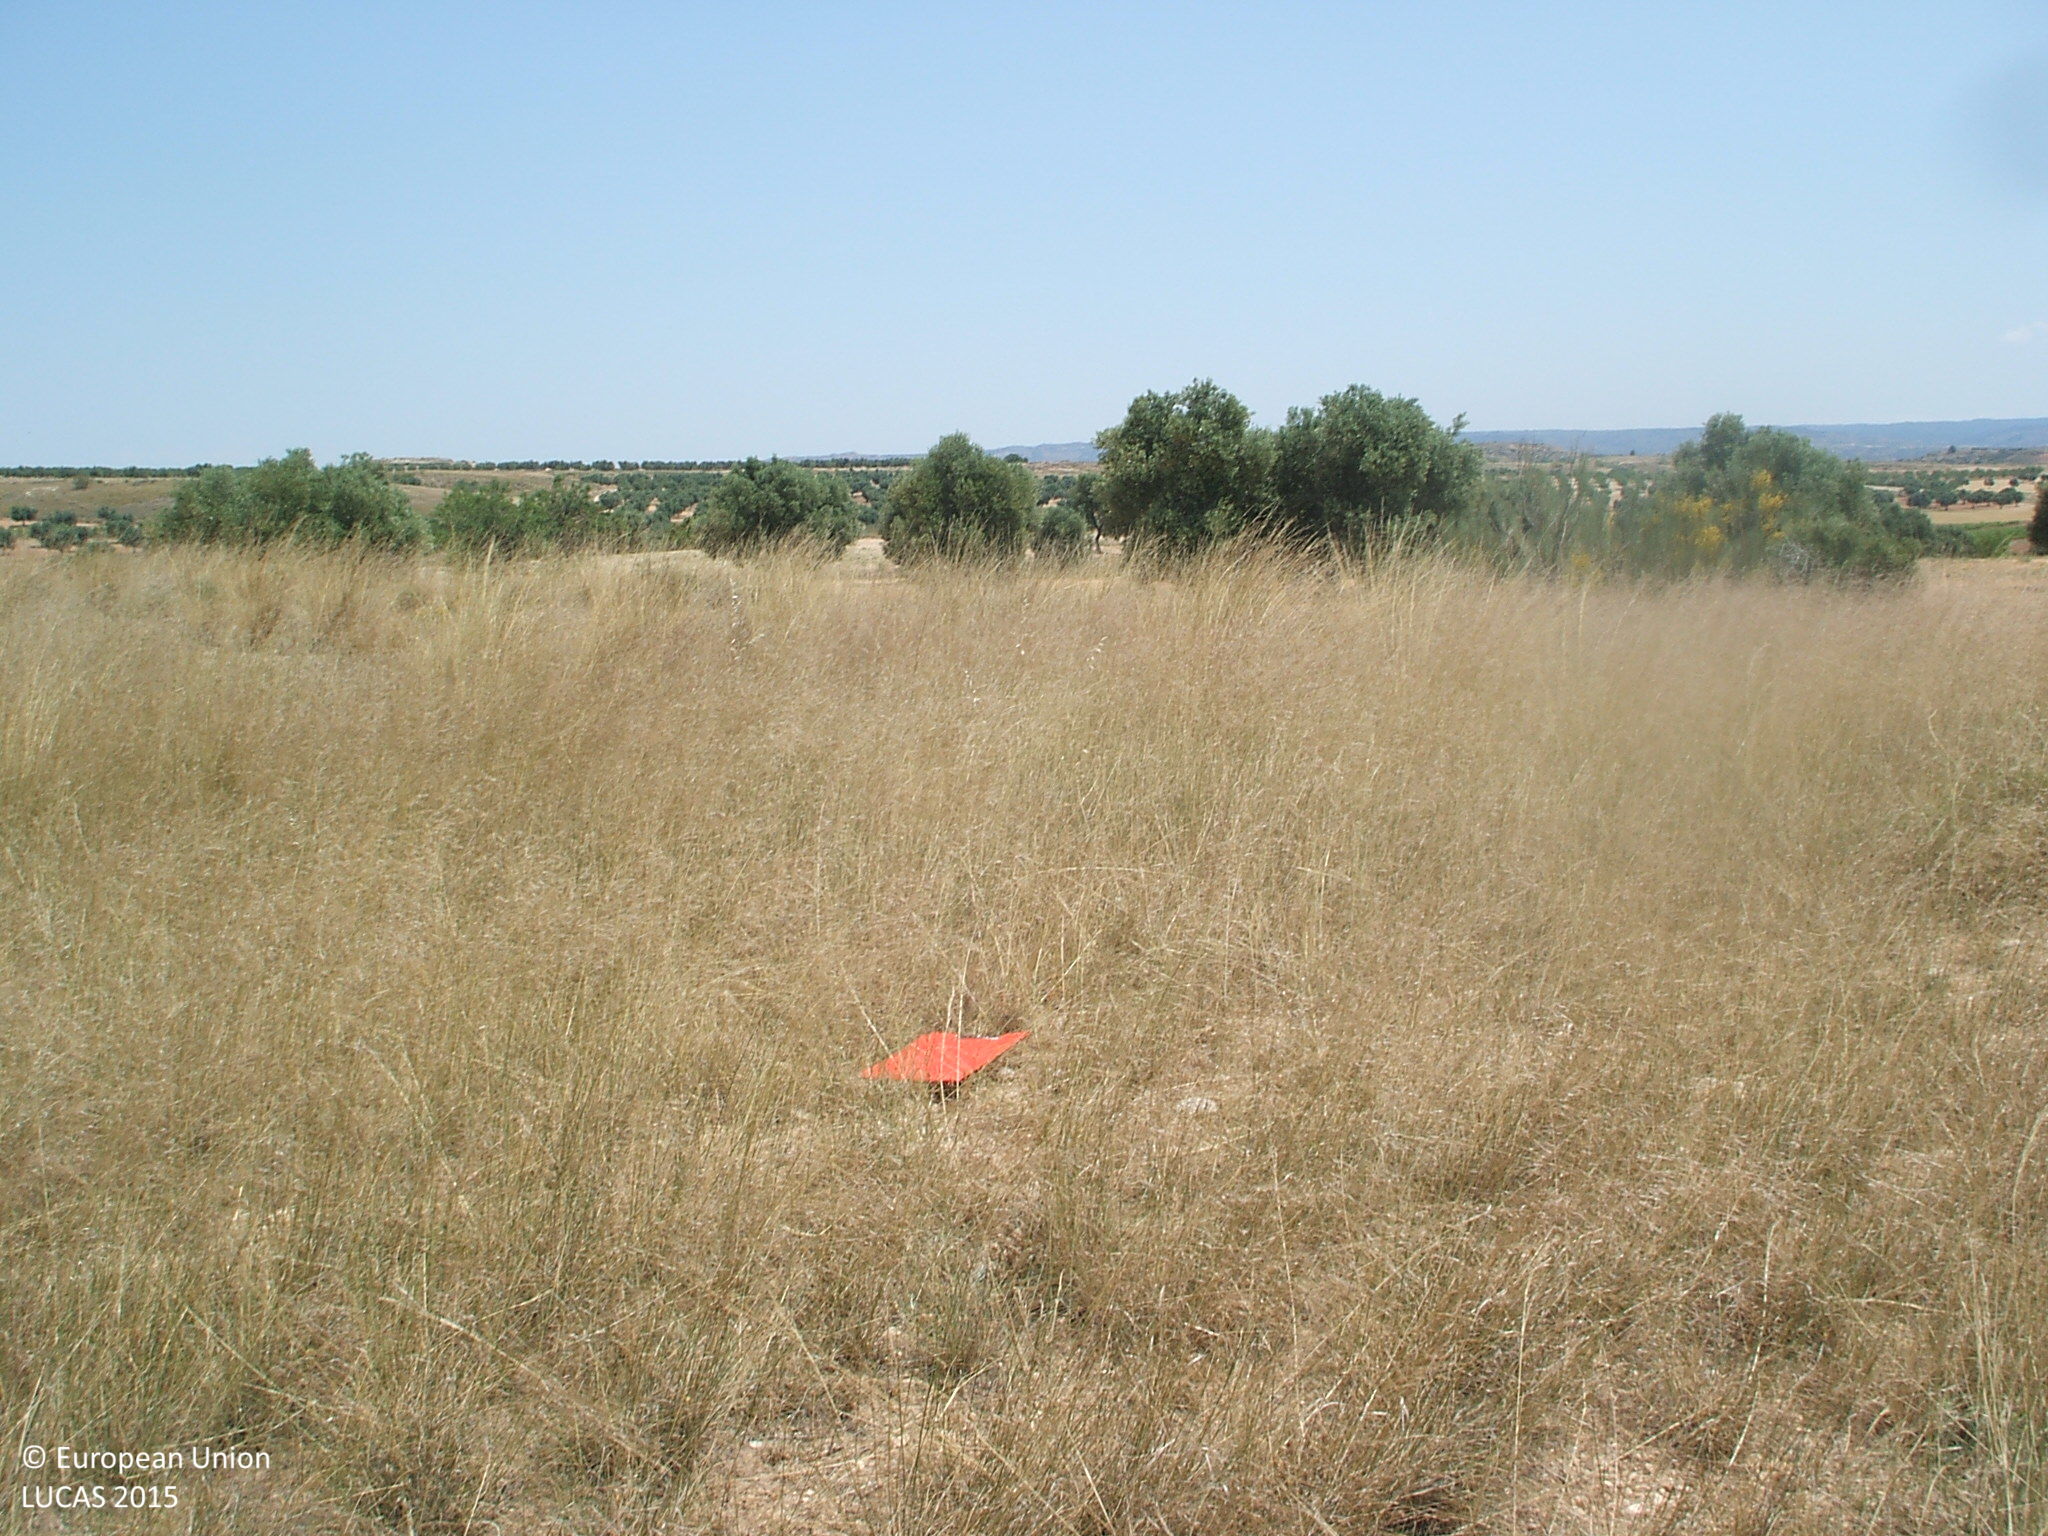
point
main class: Grassland
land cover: Grassland without tree/shrub cover
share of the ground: > 75 %
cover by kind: herbaceous plants 100 %
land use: Semi-natural and natural areas not in use
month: June
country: ES
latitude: 40.9915
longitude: -0.1983
